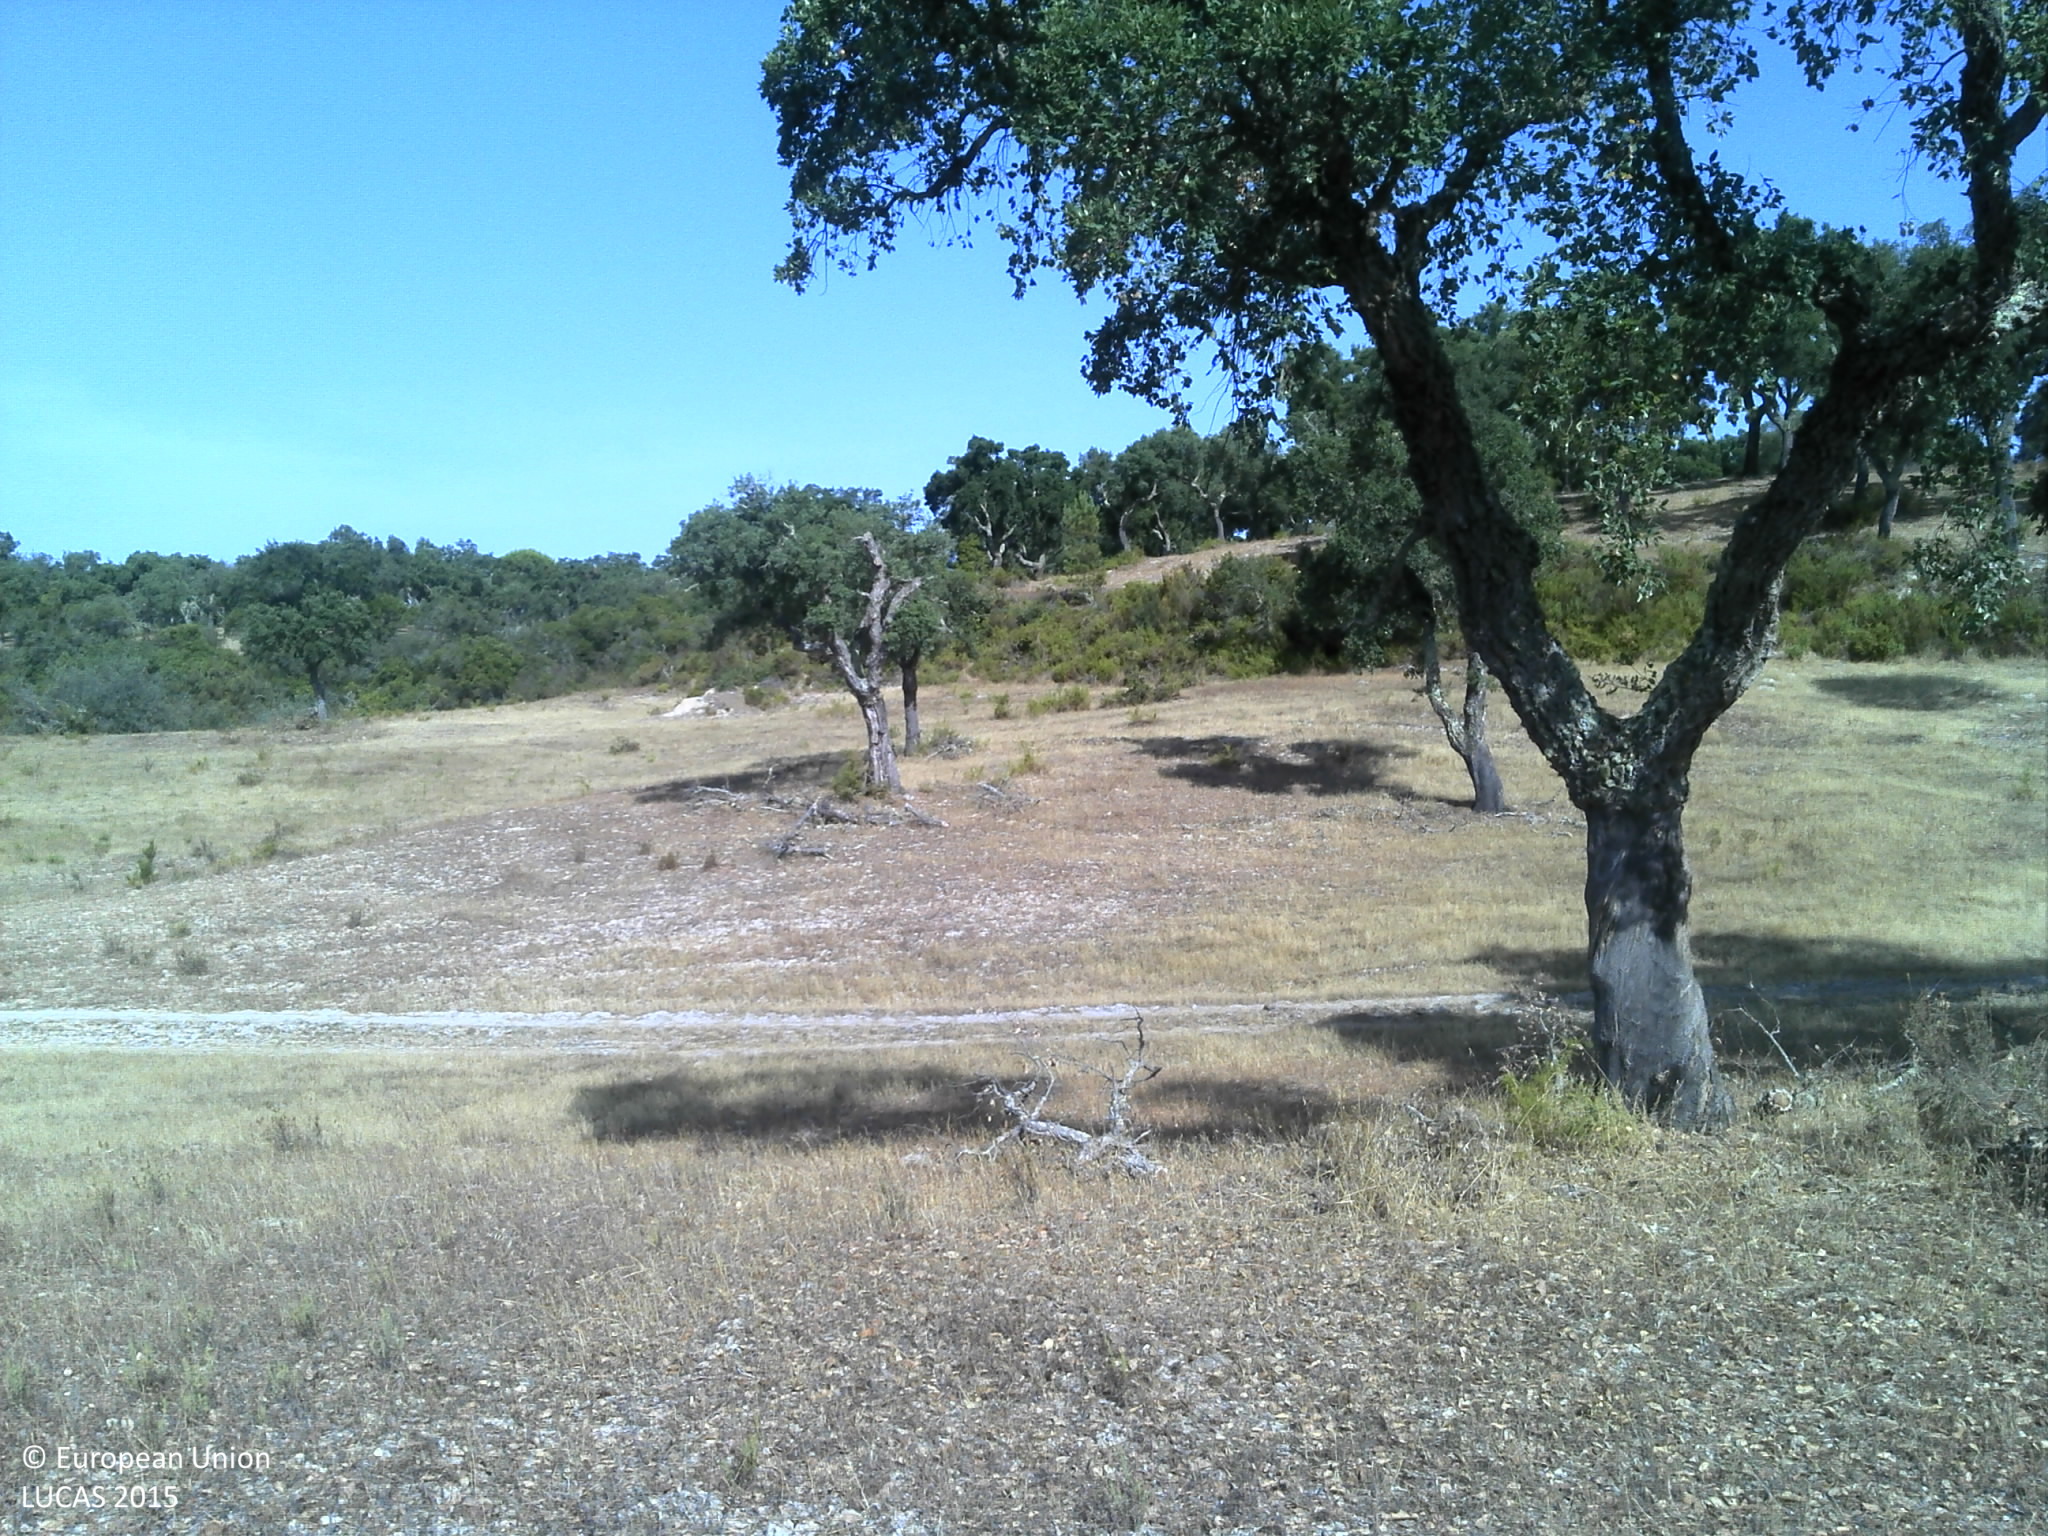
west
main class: Woodland
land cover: Broadleaved woodland
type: broadleaved evergreen forest
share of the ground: 25 - 50 %
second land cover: Grassland without tree/shrub cover
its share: 25 - 50 %
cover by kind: herbaceous plants 40 %, broadleaved forest trees 30 %, unconsolidated bare surface 30 %
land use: Forestry
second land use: Agriculture (excluding fallow land and kitchen gardens)
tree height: > 5 m
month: July
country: PT
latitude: 39.1170
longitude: -8.3228
